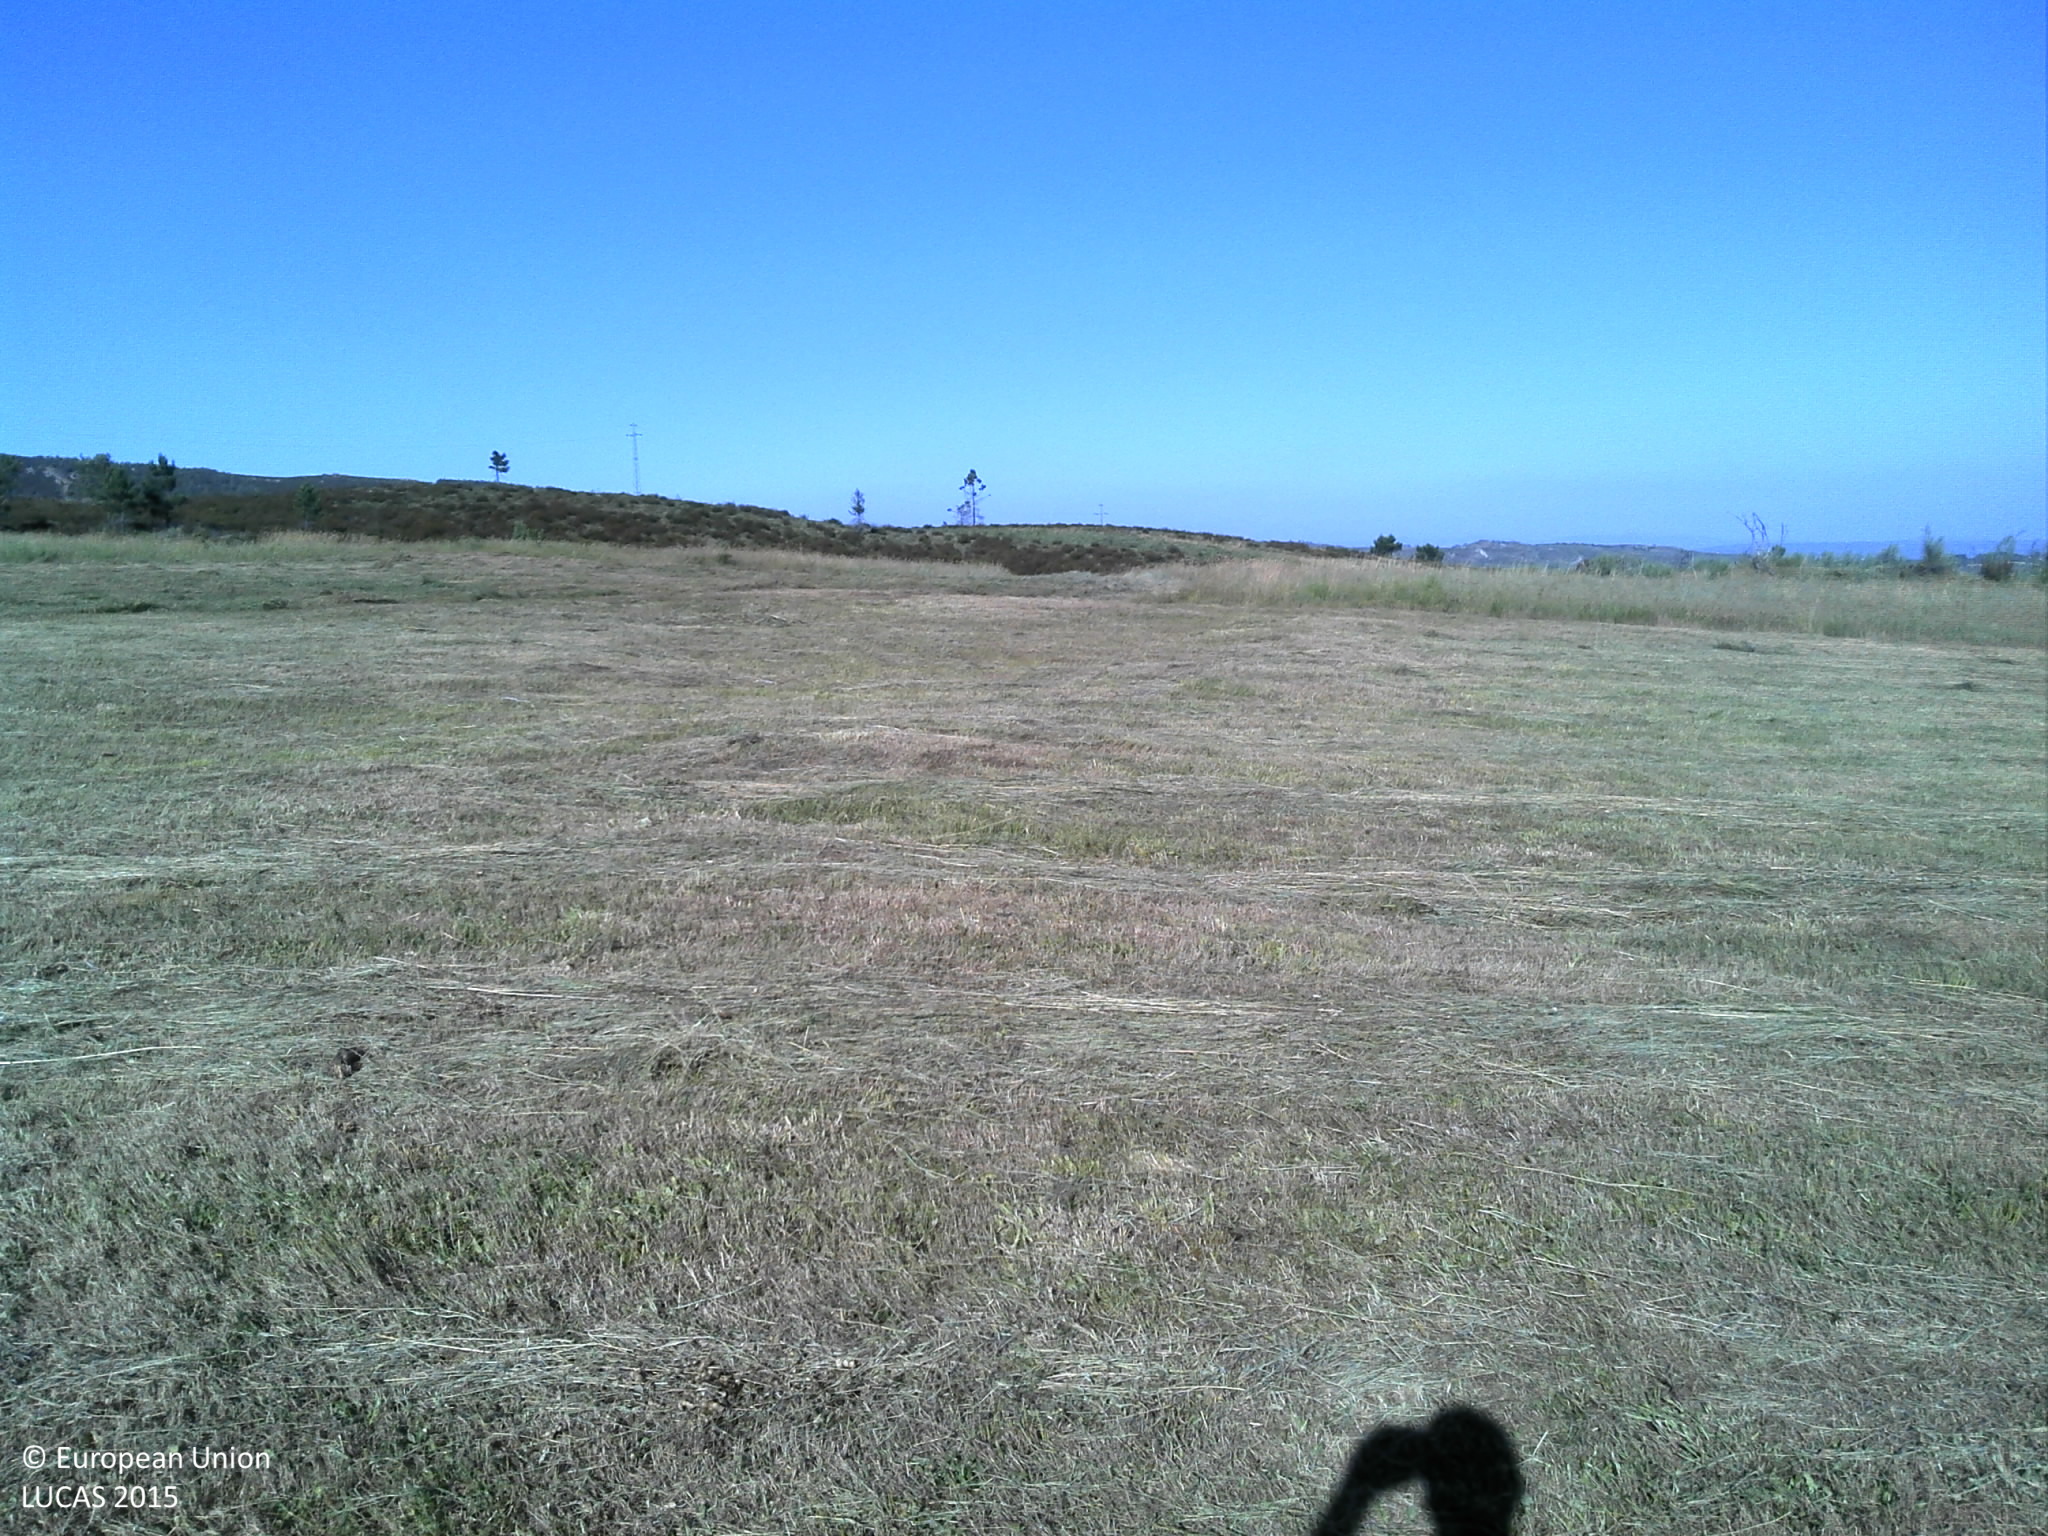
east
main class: Grassland
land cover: Grassland without tree/shrub cover
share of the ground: > 75 %
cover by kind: herbaceous plants 90 %, unconsolidated bare surface 10 %
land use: Agriculture (excluding fallow land and kitchen gardens)
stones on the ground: < 10 %
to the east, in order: Grassland without tree/shrub cover; Shrubland without tree cover; Grassland without tree/shrub cover; Tracks; Shrubland without tree cover
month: July
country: PT
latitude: 41.8004
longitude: -7.6966
